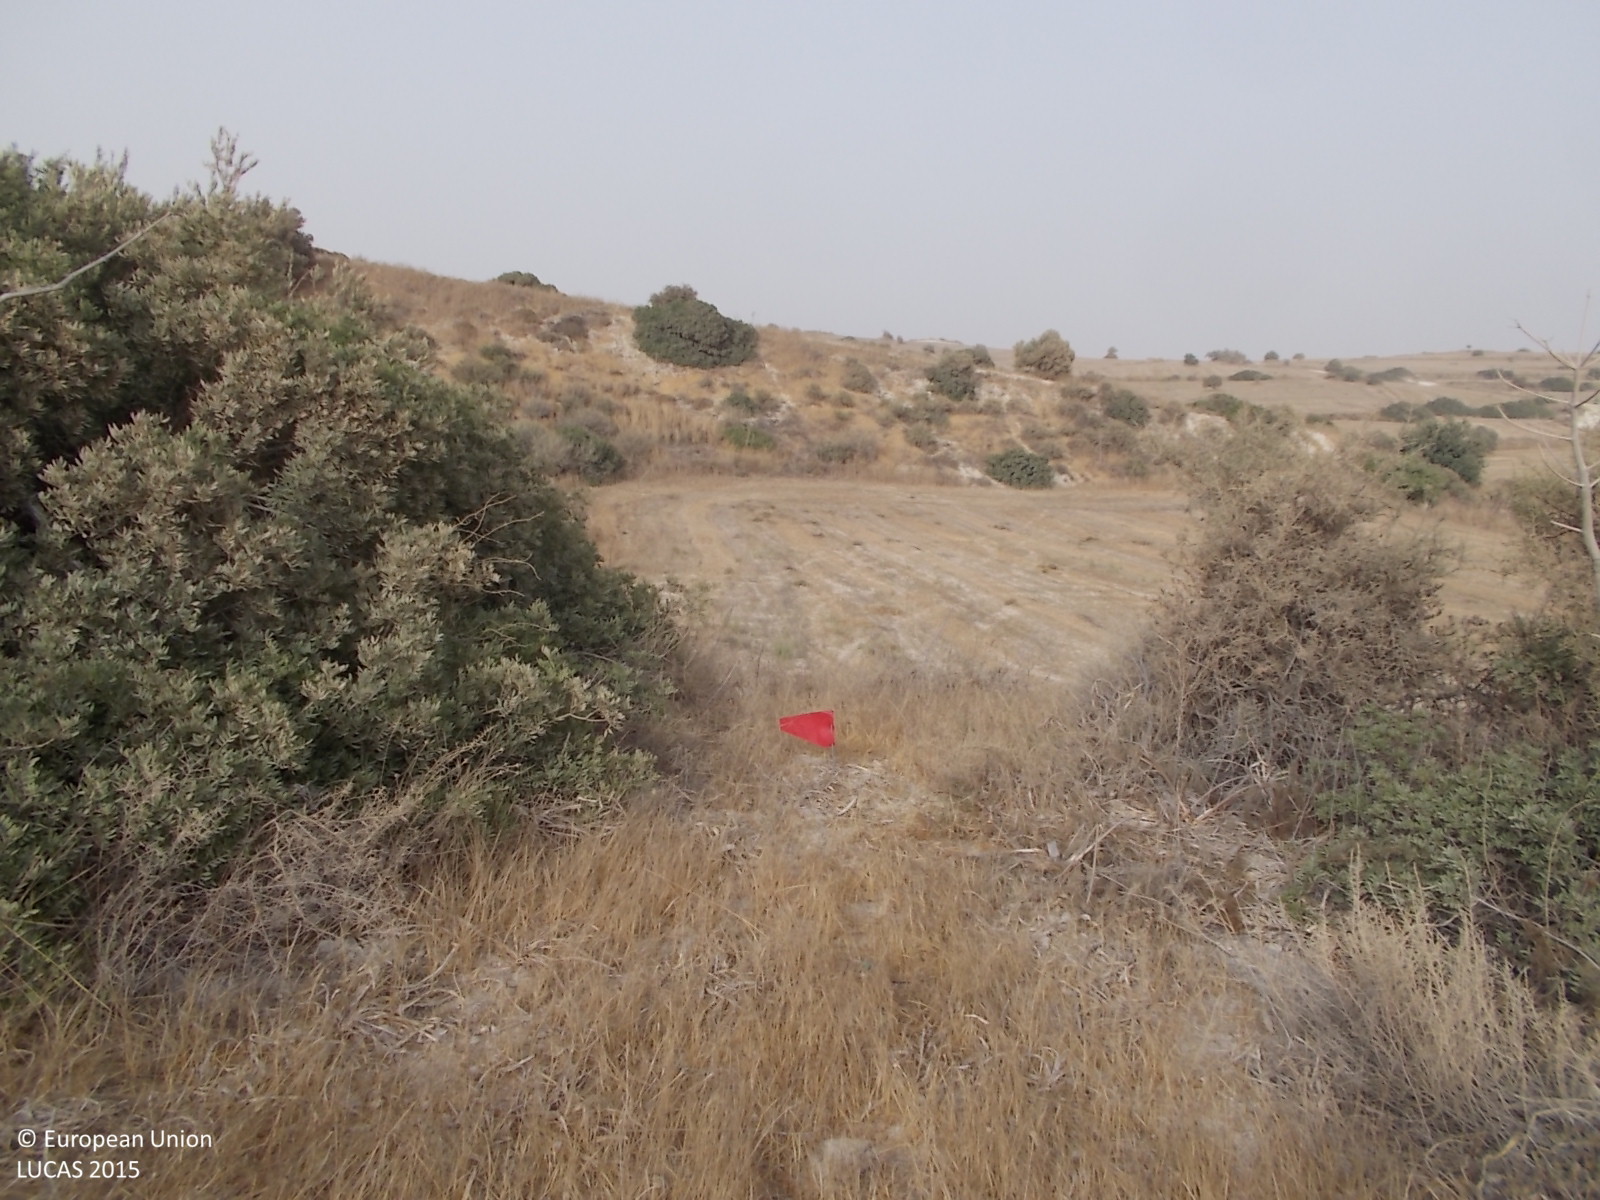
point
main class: Woodland
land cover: Broadleaved woodland
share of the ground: 25 - 50 %
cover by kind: herbaceous plants 60 %, broadleaved forest trees 30 %, unconsolidated bare surface 10 %
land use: Semi-natural and natural areas not in use
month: April
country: CY
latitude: 34.8006
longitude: 33.4103
